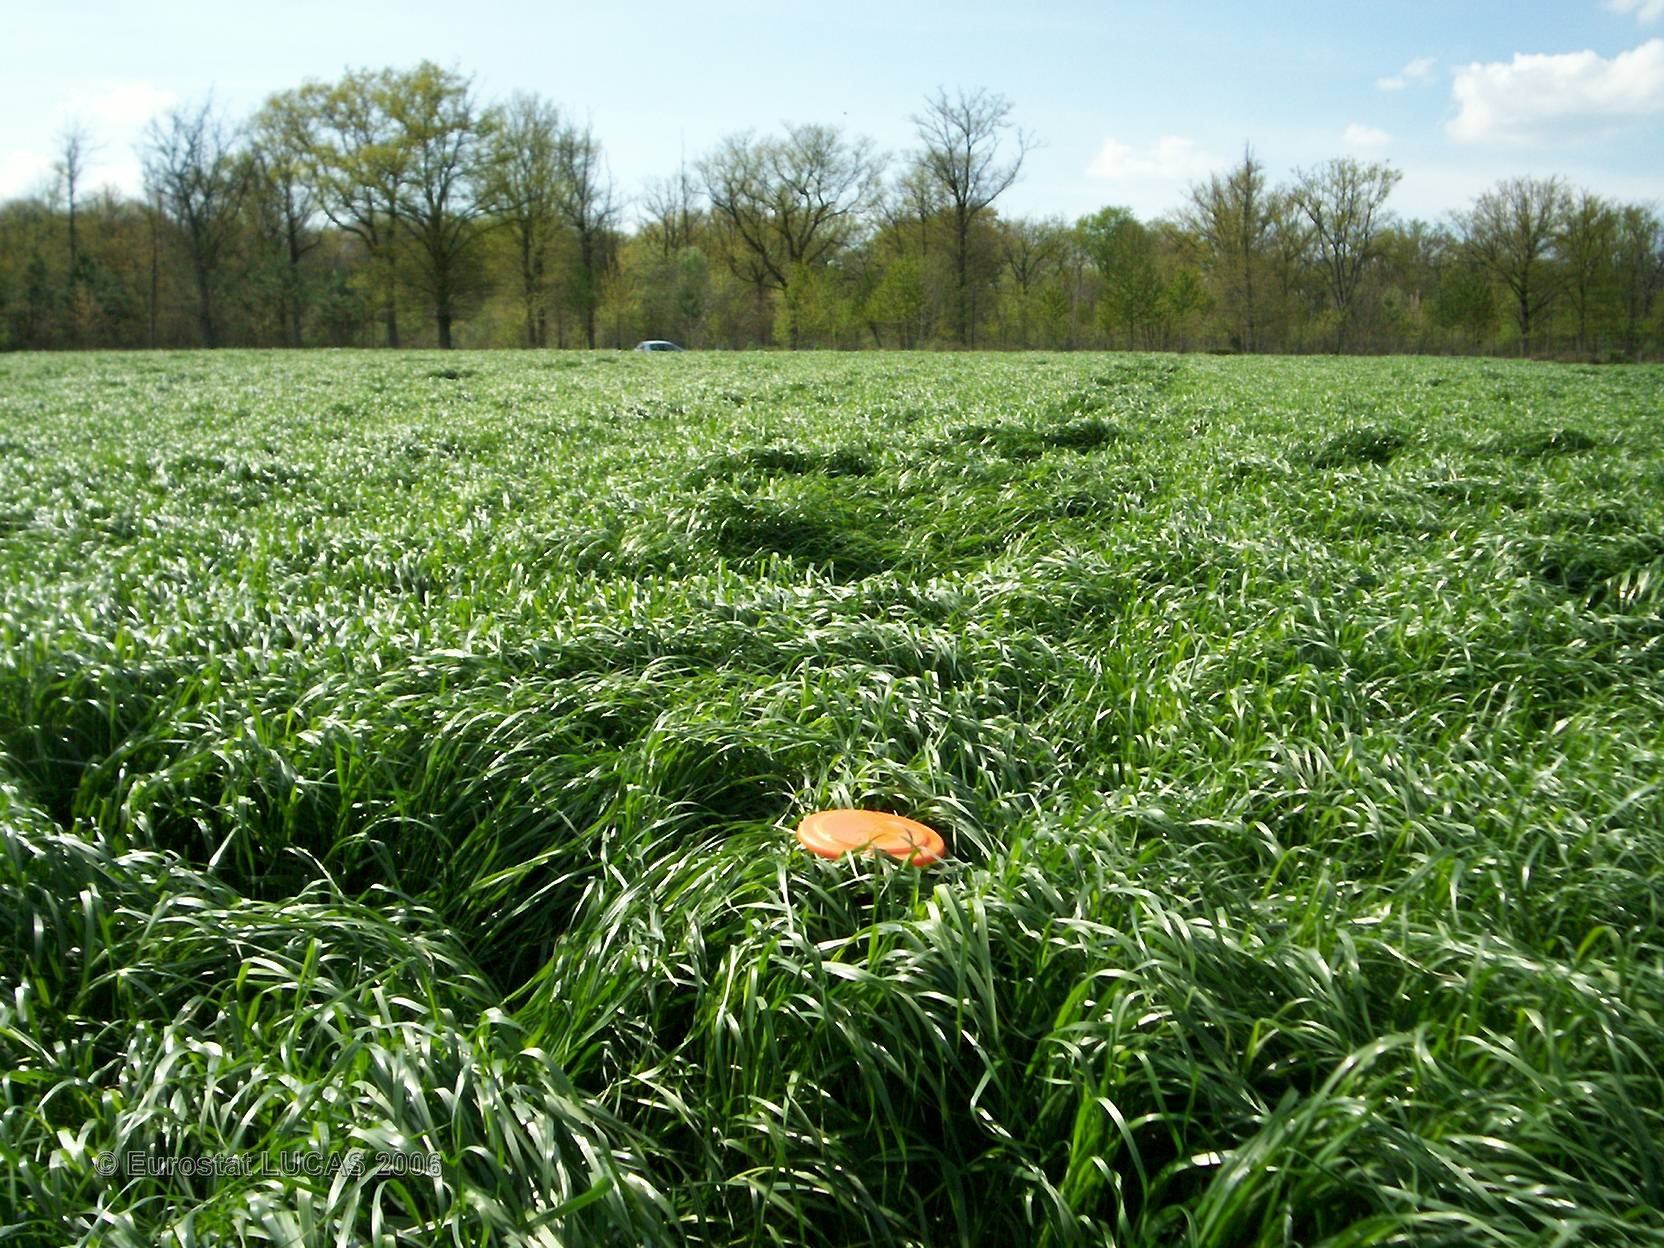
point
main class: Grassland
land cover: Grassland without tree/shrub cover
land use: Agriculture (excluding fallow land and kitchen gardens)
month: April
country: FR
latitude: 46.9256
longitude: 0.5120
